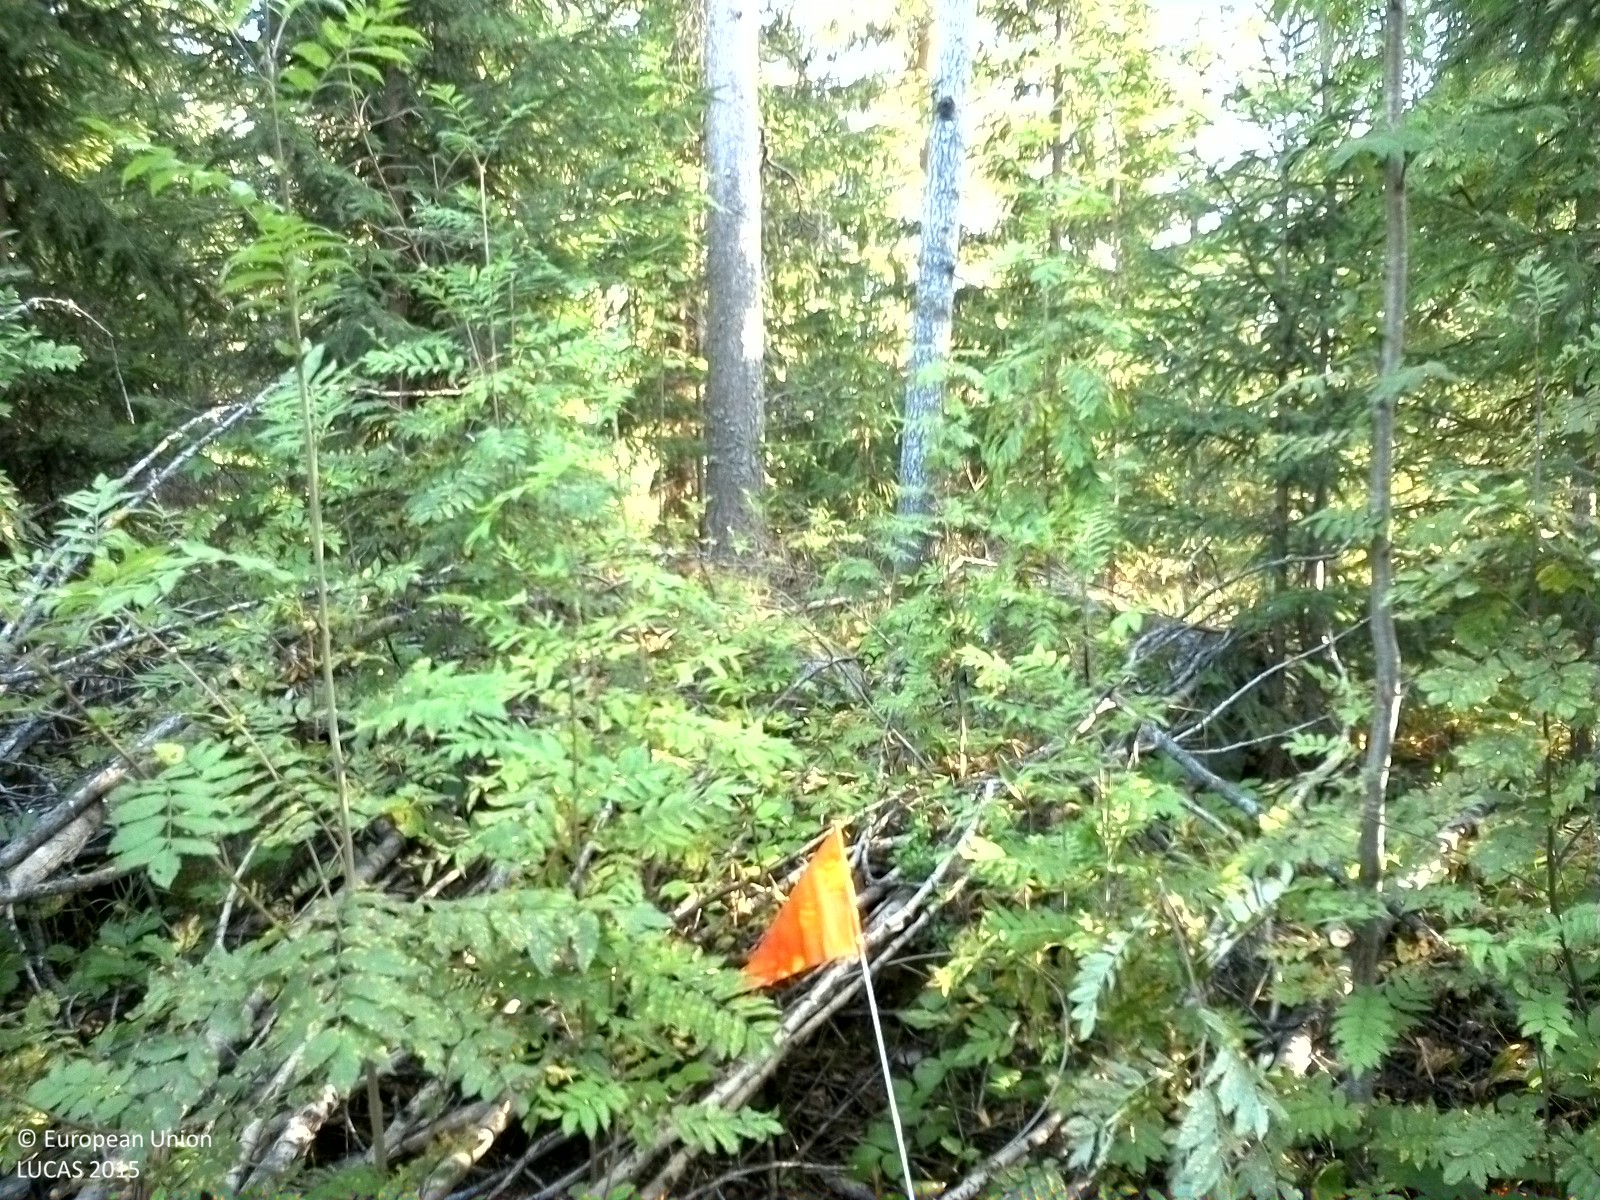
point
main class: Woodland
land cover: Other mixed woodland
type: boreal forest
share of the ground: 50 - 75 %
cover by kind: coniferous forest trees 40 %, broadleaved forest trees 20 %, herbaceous plants 20 %
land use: Forestry
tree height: > 5 m
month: August
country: SE
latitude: 62.3414
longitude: 16.9899
